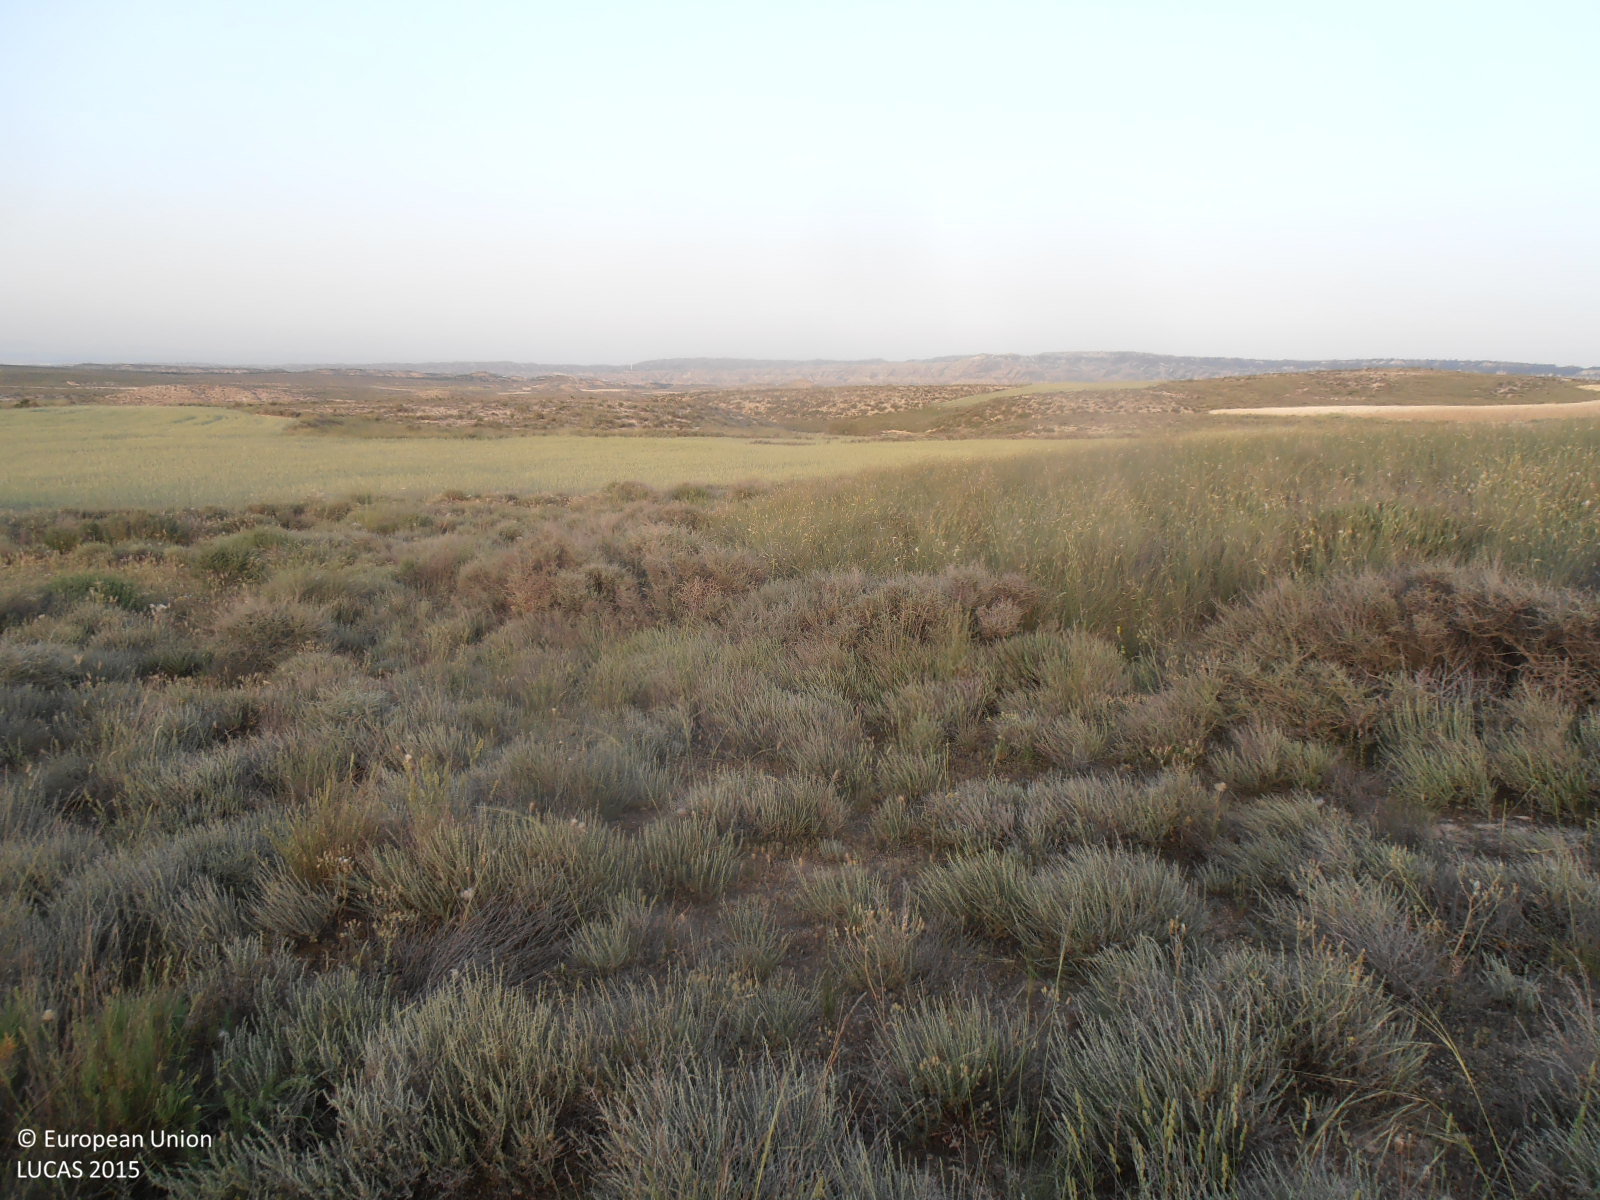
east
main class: Shrubland
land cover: Shrubland without tree cover
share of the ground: > 75 %
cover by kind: shrubs 90 %, herbaceous plants 10 %
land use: Semi-natural and natural areas not in use
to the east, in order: Shrubland without tree cover; Tracks; Grass margins; Rye; Shrubland without tree cover; Rye
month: May
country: ES
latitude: 41.5567
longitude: -1.0409
